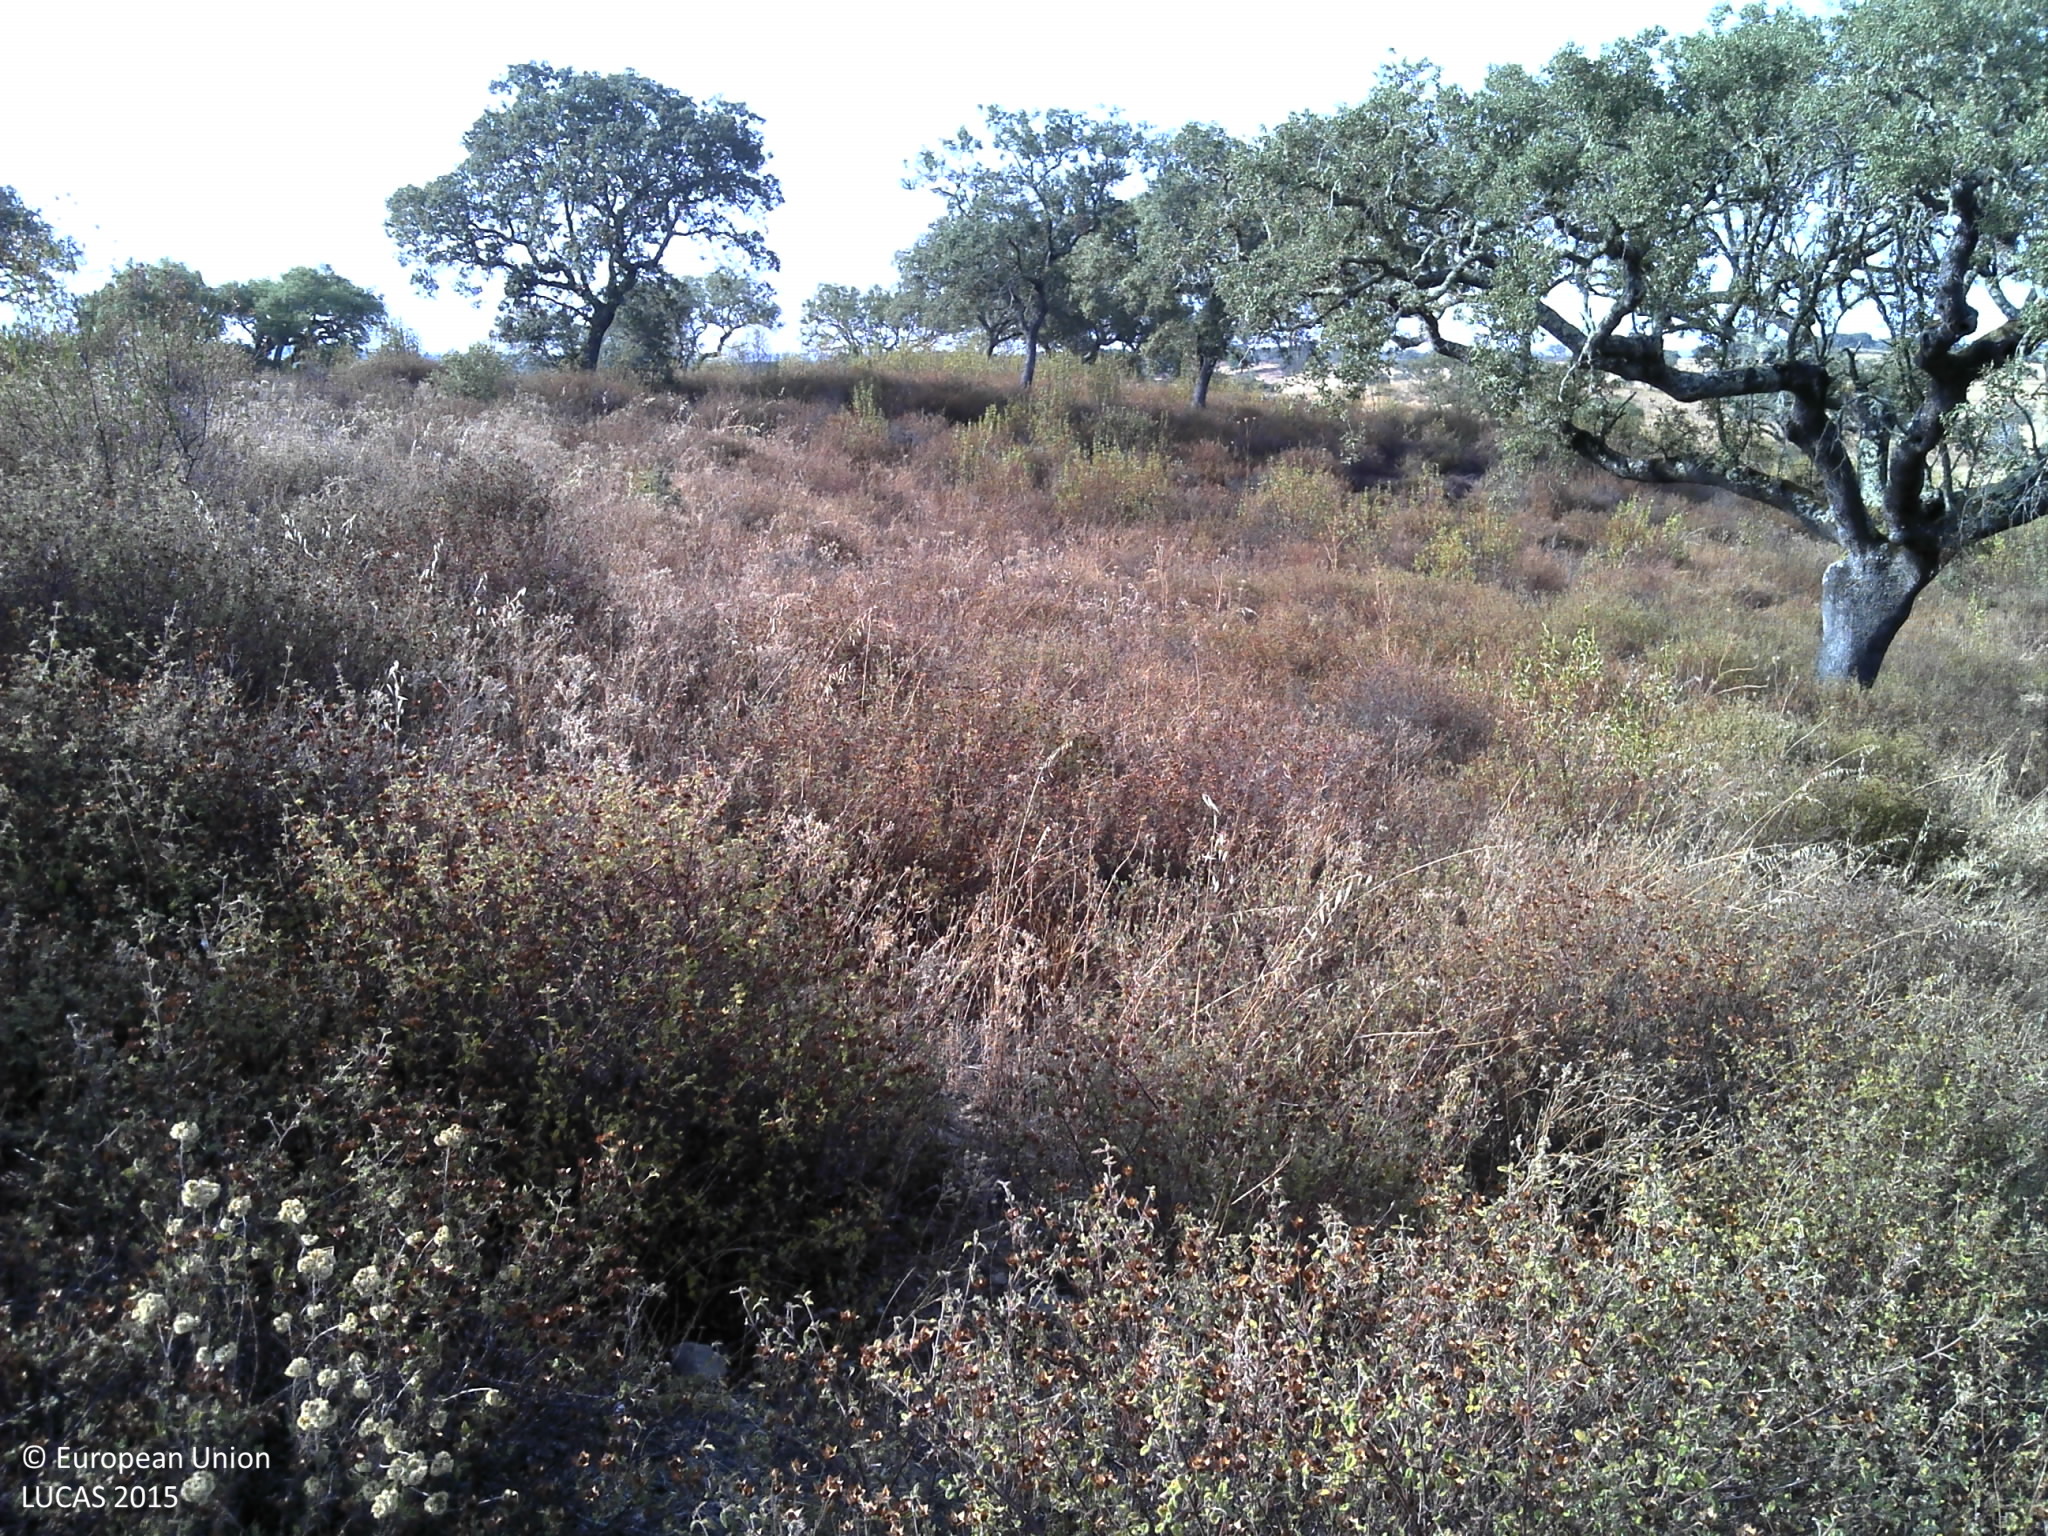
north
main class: Grassland
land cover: Grassland with sparse tree/shrub cover
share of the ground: > 75 %
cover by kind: herbaceous plants 80 %, consolidated bare surface 15 %, broadleaved forest trees 5 %
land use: Agriculture (excluding fallow land and kitchen gardens)
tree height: > 5 m
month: July
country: PT
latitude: 37.6302
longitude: -8.2613
